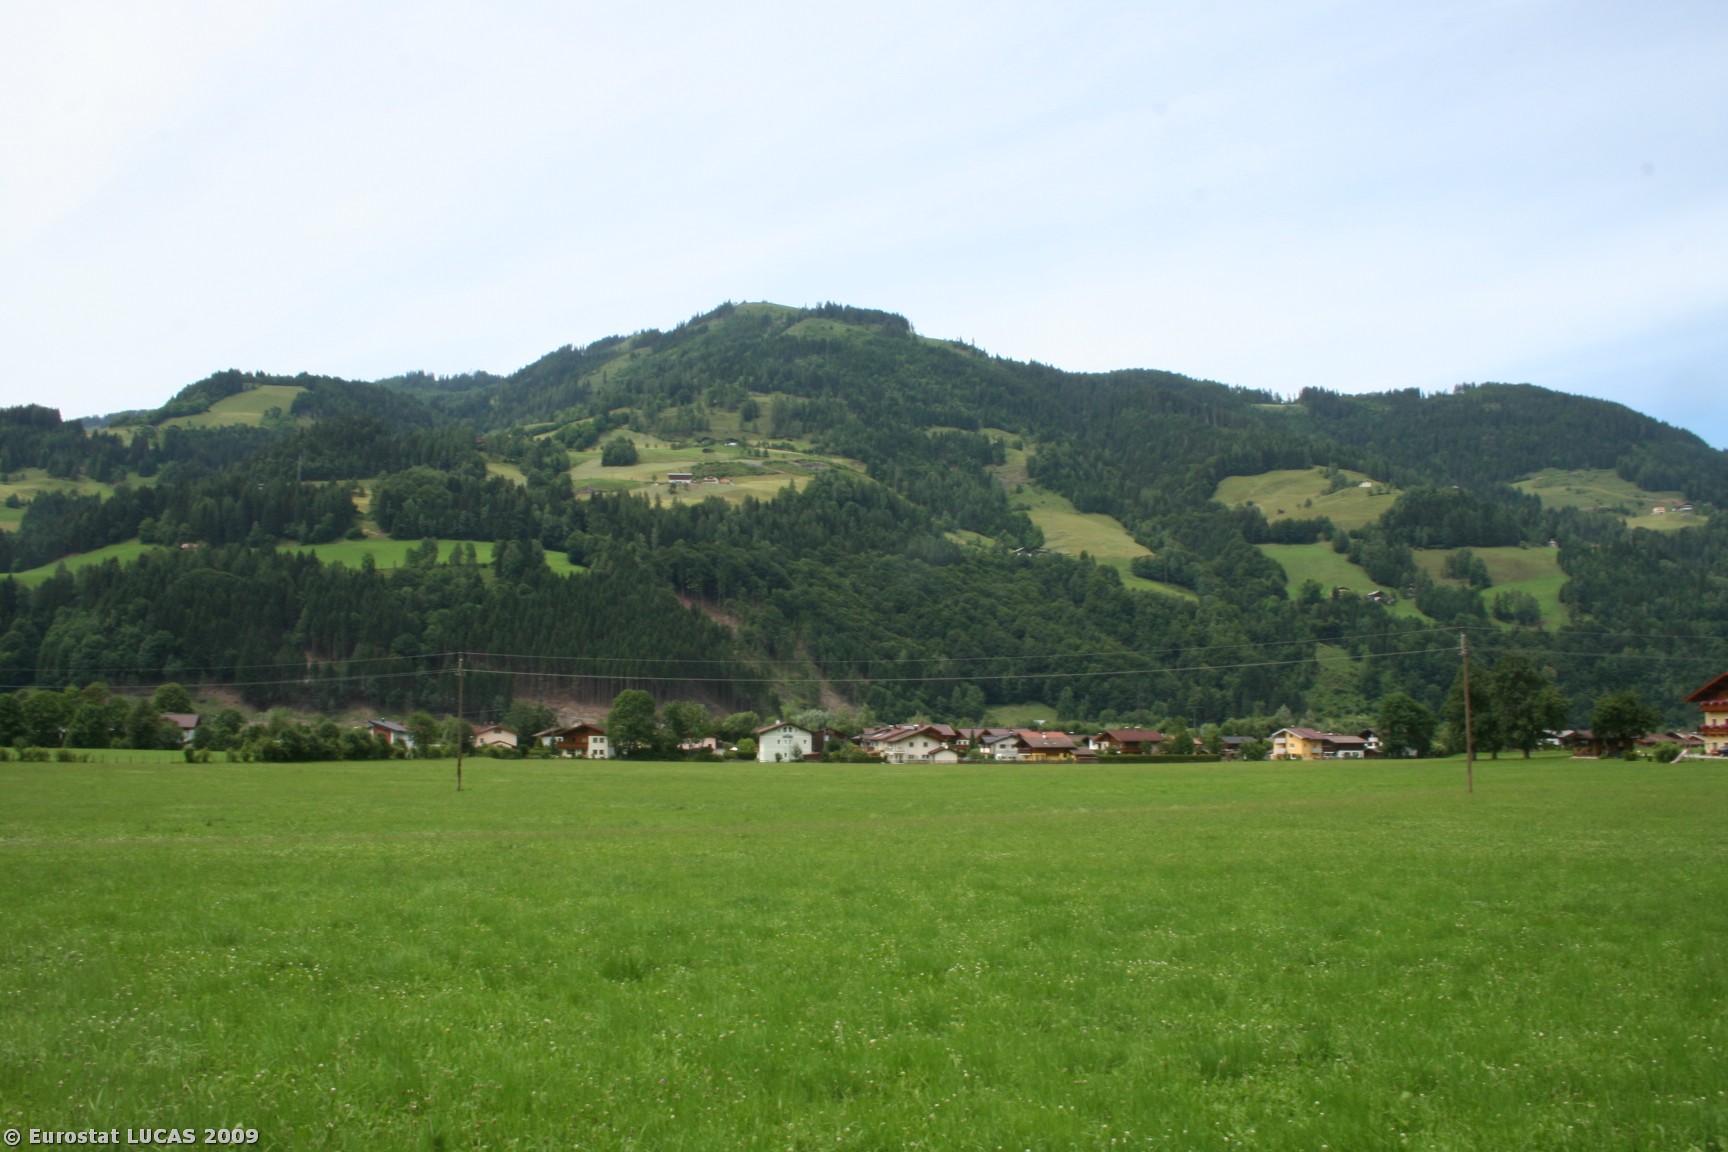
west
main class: Grassland
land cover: Grassland without tree/shrub cover
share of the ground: > 75 %
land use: Agriculture (excluding fallow land and kitchen gardens)
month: June
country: AT
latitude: 47.3661
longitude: 13.2159
